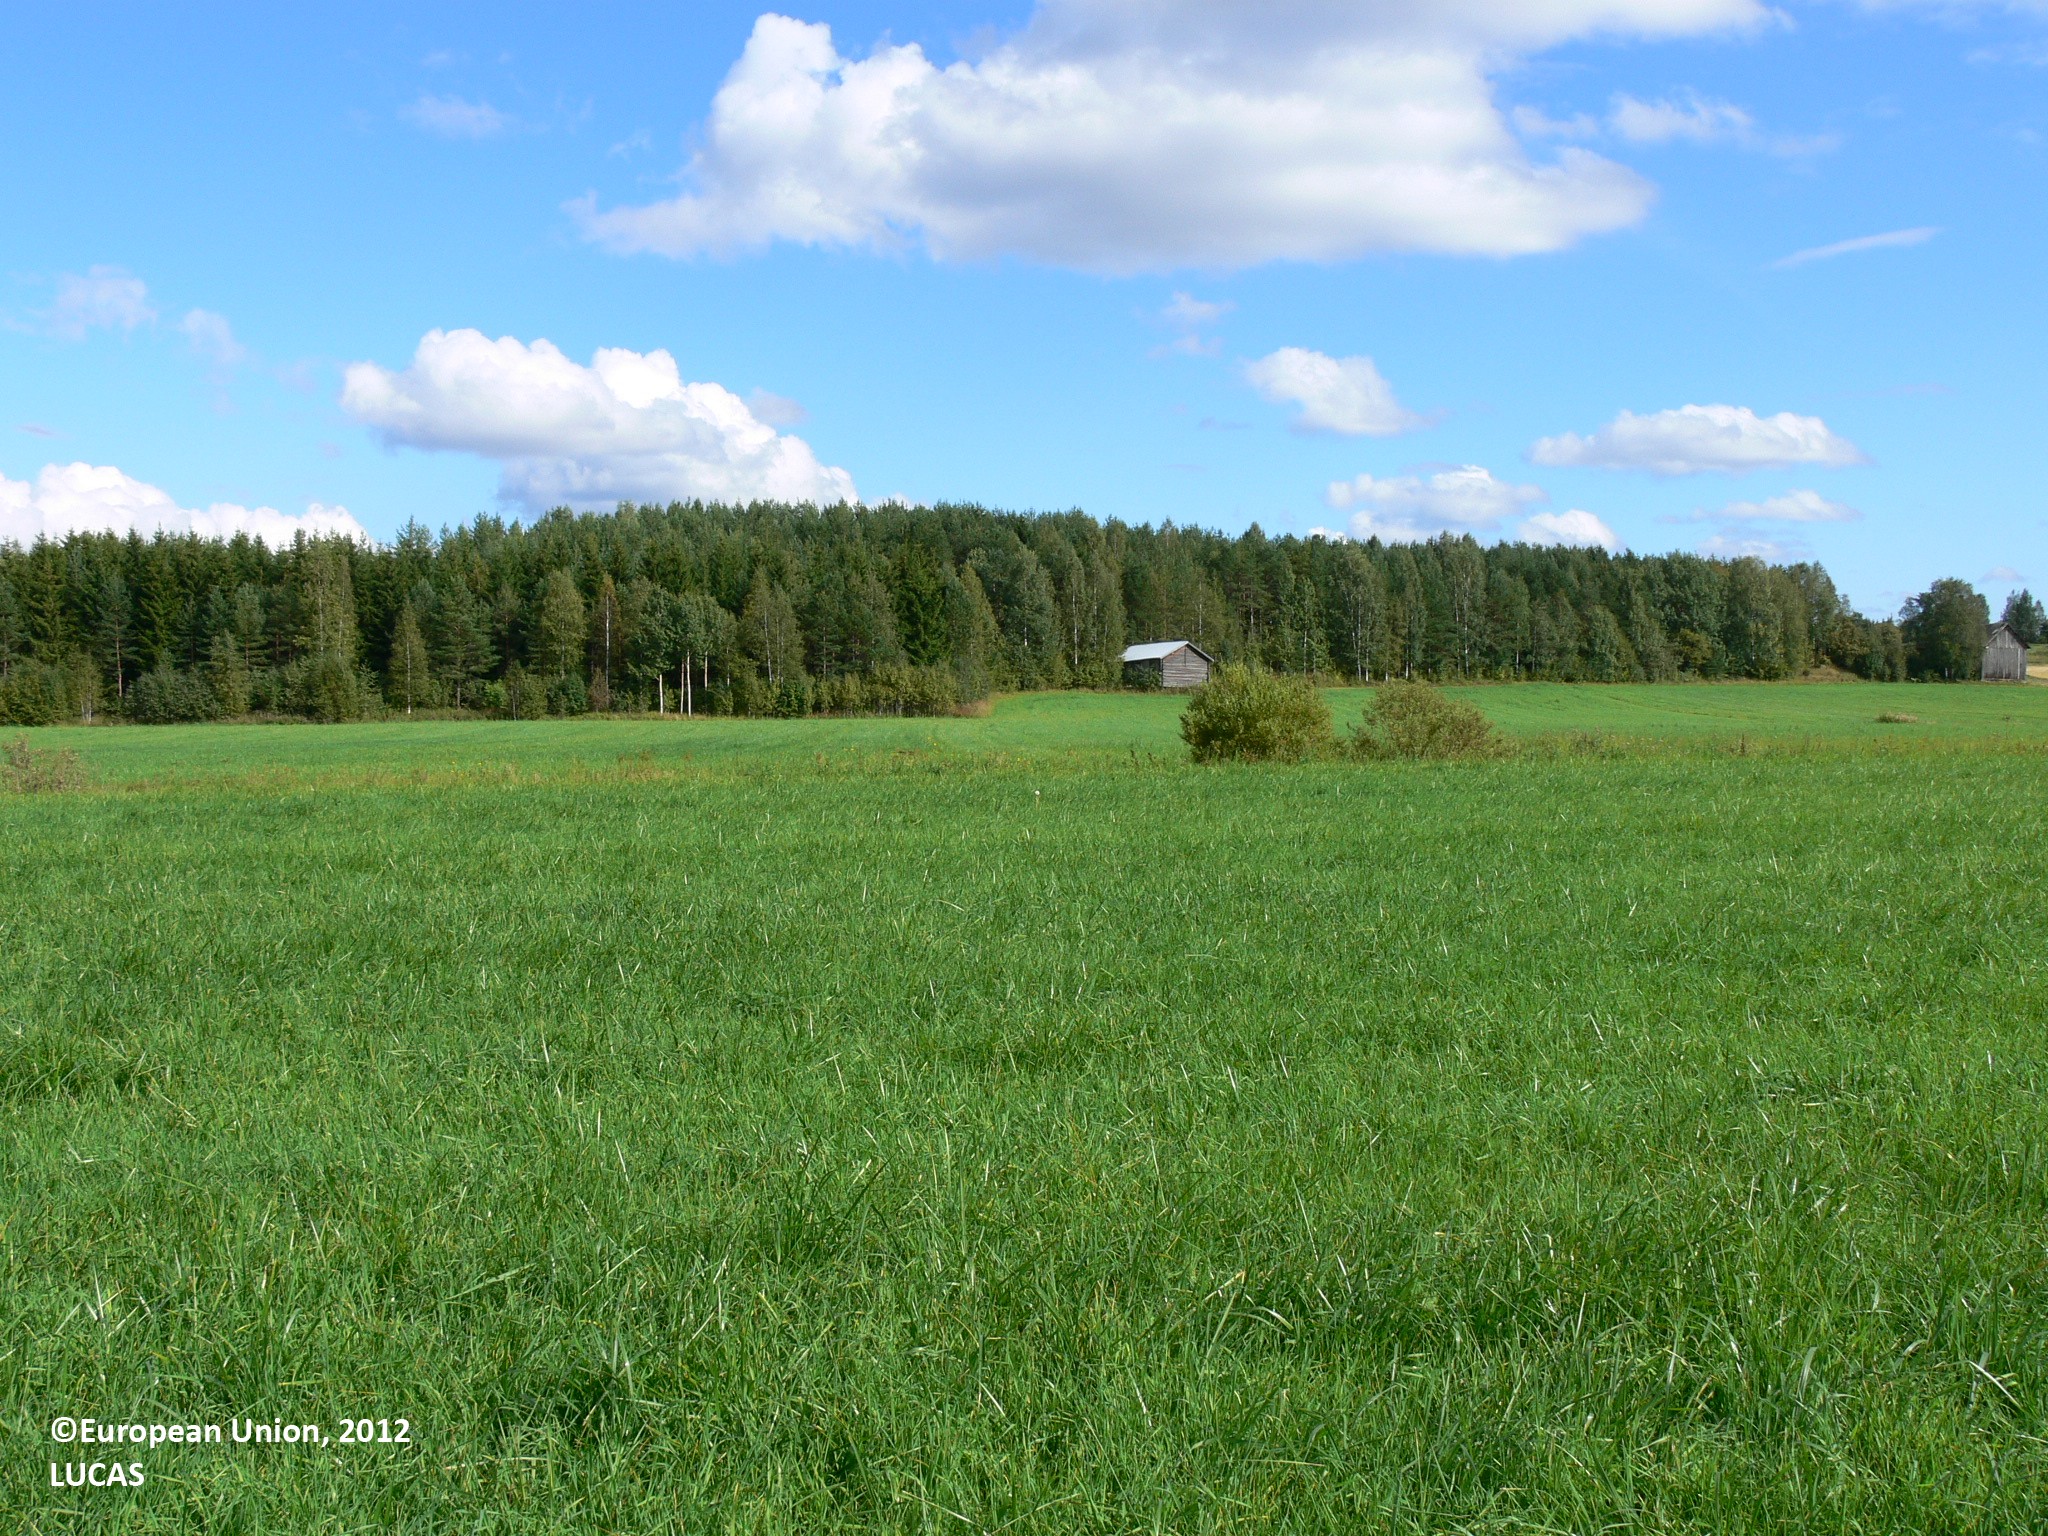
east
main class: Cropland
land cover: Temporary grasslands
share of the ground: > 75 %
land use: Agriculture (excluding fallow land and kitchen gardens)
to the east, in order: Temporary grasslands; Ditches and canals; Temporary grasslands; Grass margins; Soya; Pine dominated coniferous woodland
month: August
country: FI
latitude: 62.0742
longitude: 30.2392
